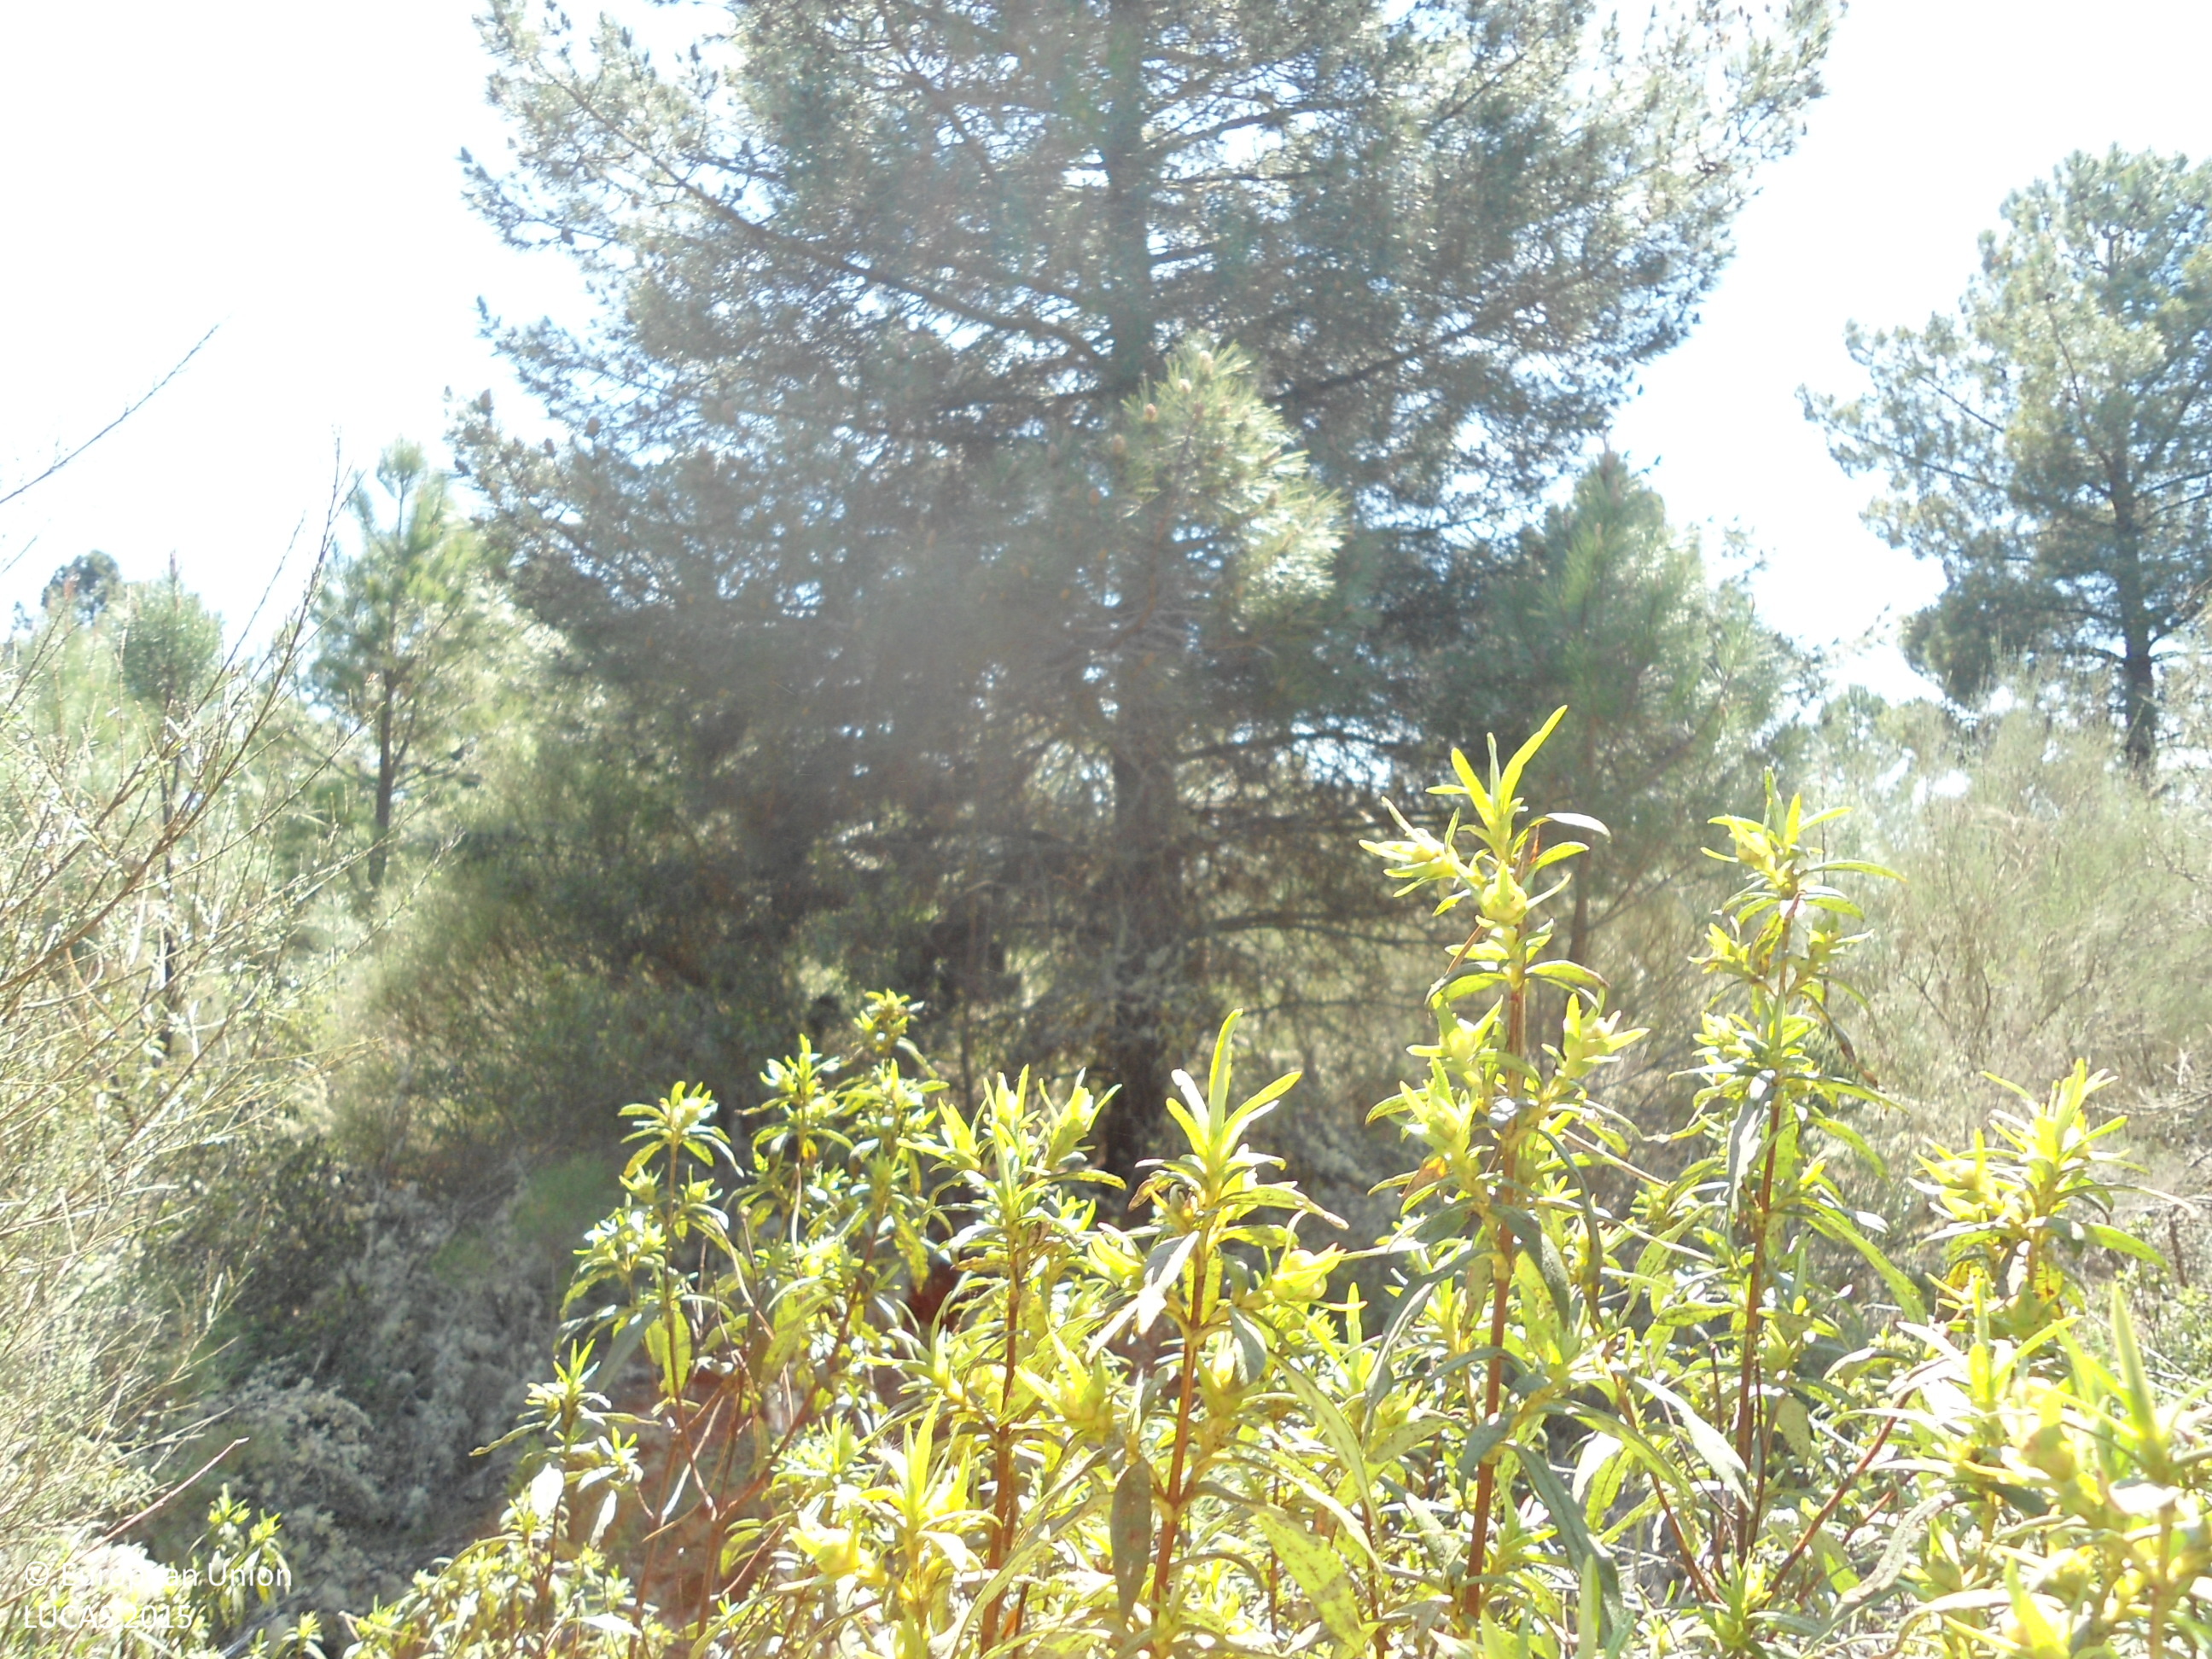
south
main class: Woodland
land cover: Pine dominated coniferous woodland
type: coniferous forest of the mediterranean region
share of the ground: > 75 %
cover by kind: coniferous forest trees 85 %, shrubs 15 %
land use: Forestry
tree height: < 5 m
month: April
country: ES
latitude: 41.8596
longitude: -6.2811
